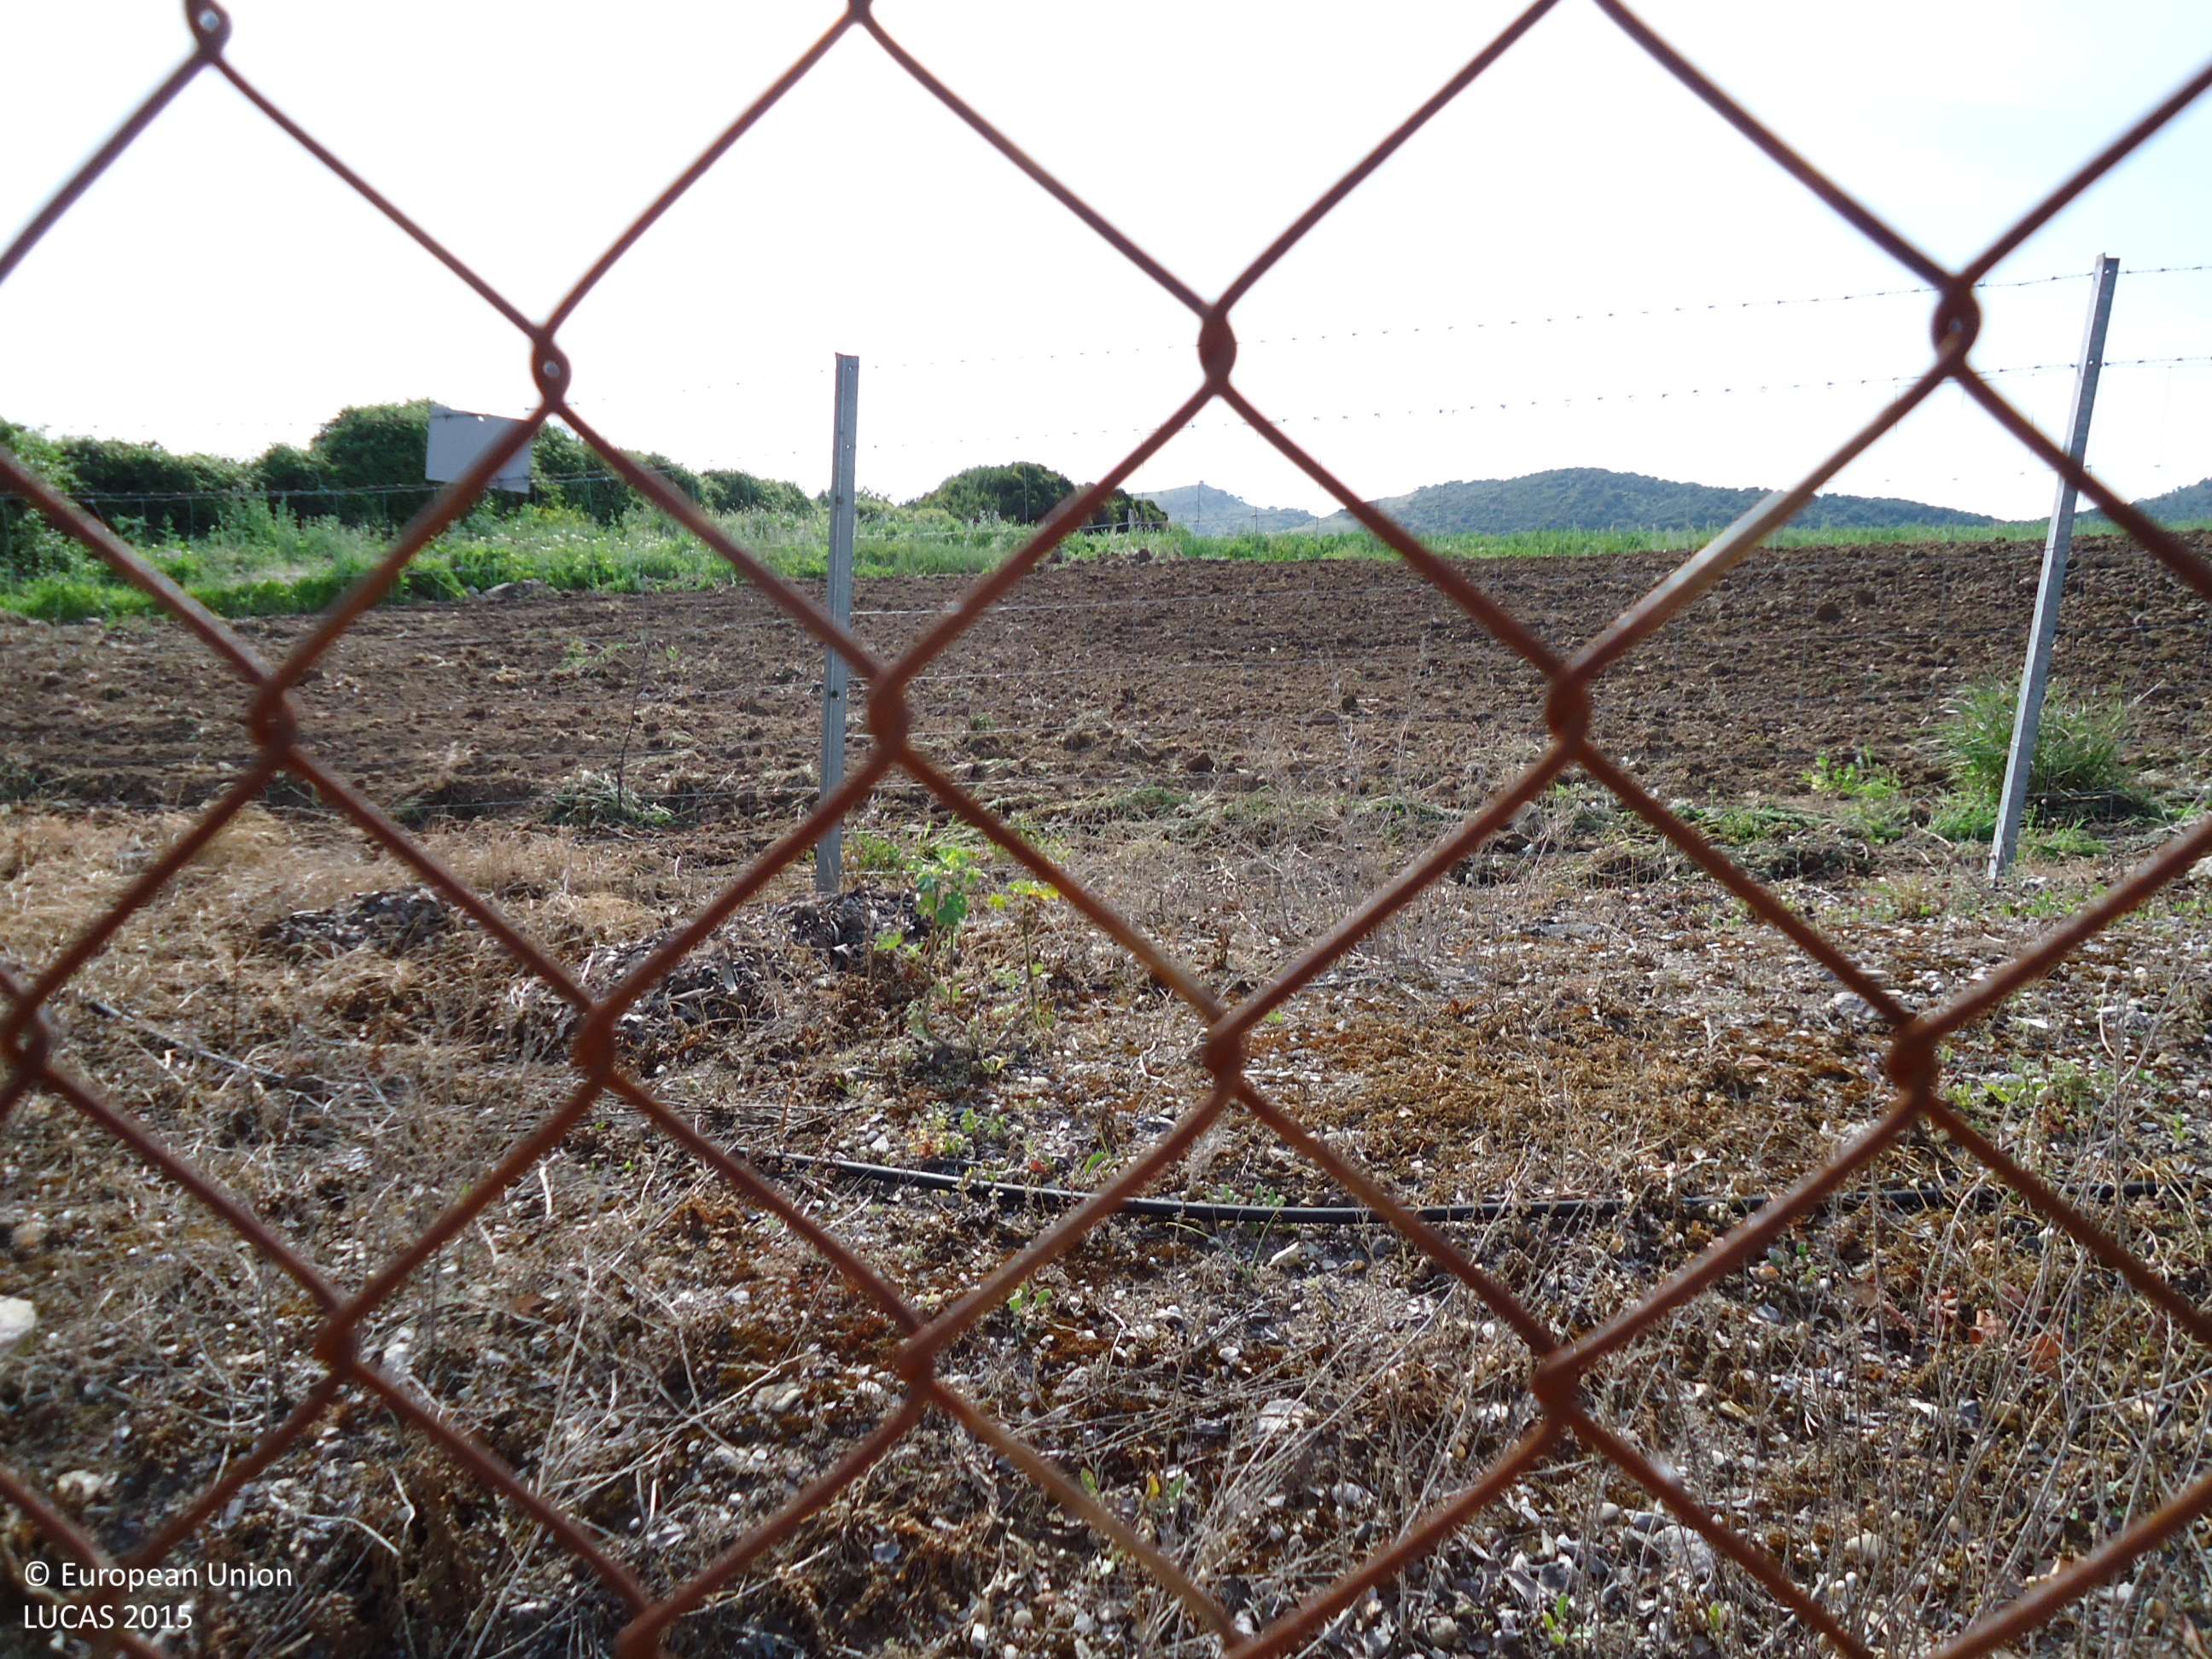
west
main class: Grassland
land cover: Spontaneously vegetated surfaces
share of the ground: > 75 %
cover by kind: herbaceous plants 100 %
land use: Fallow land
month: April
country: ES
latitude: 36.8952
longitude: -5.4811
